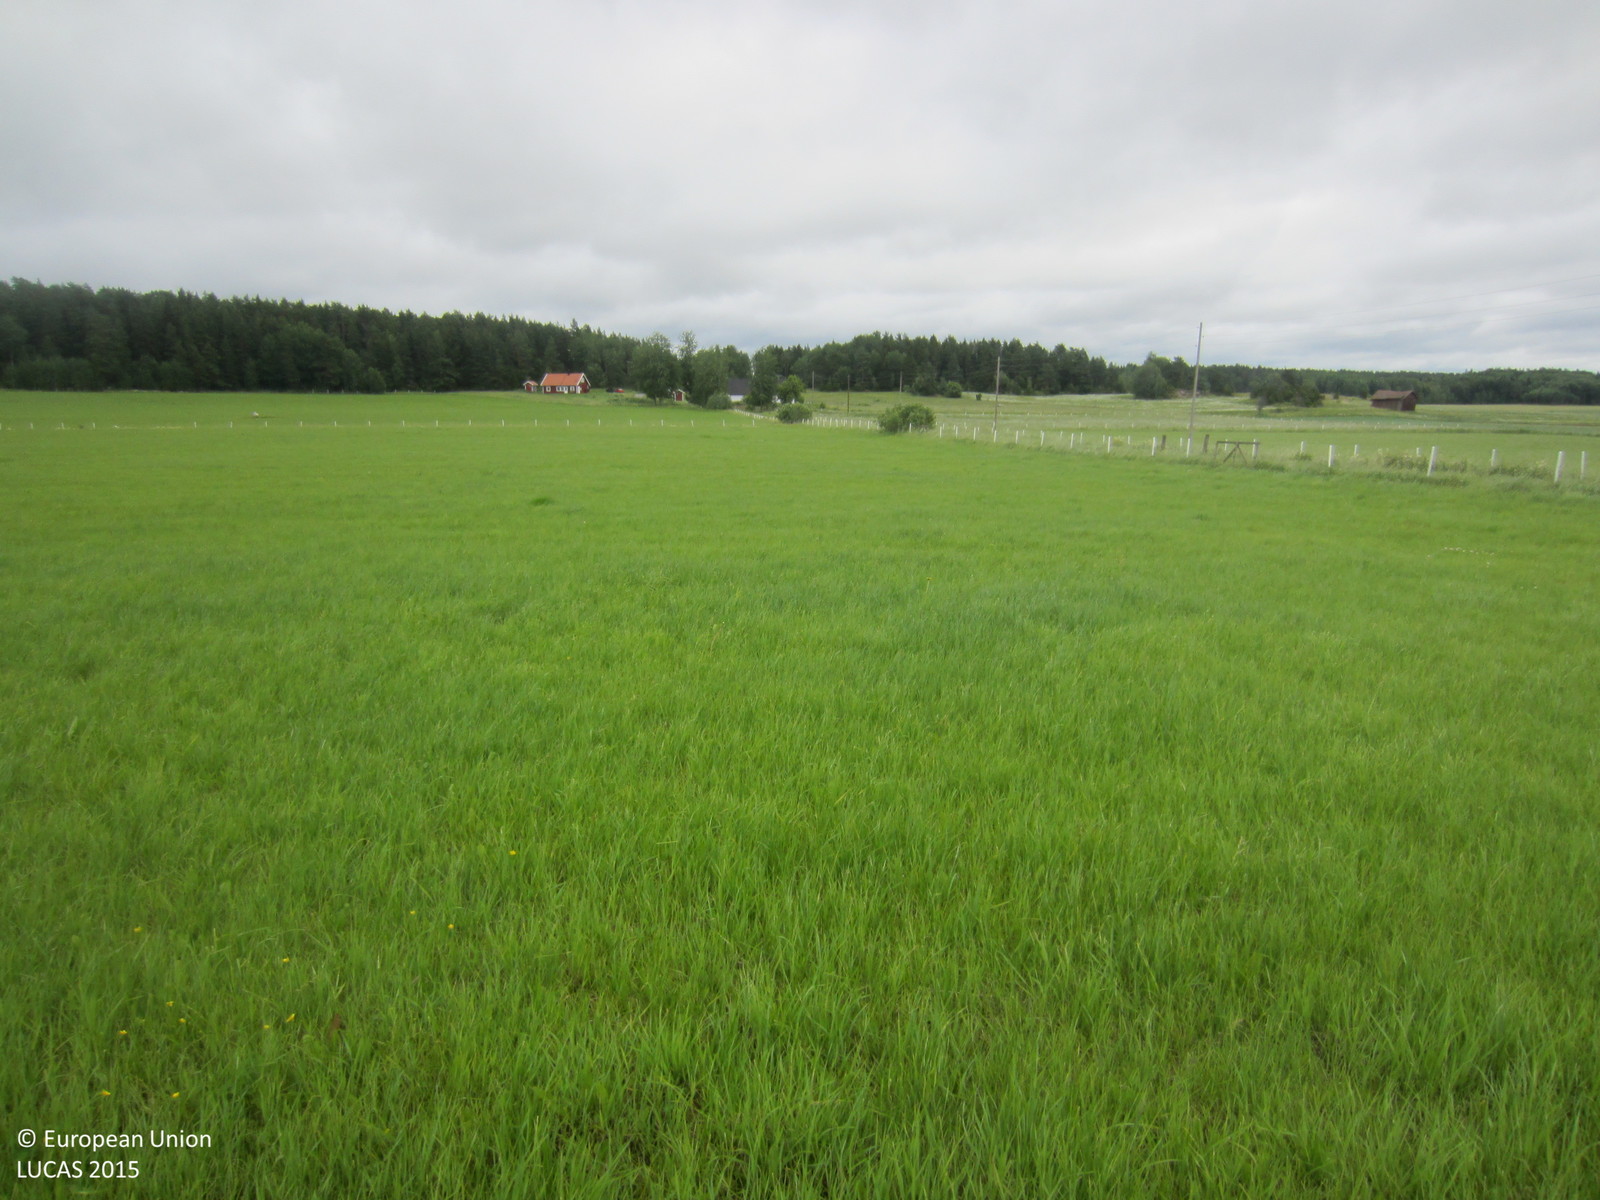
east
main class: Grassland
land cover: Grassland without tree/shrub cover
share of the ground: > 75 %
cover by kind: herbaceous plants 100 %
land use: Agriculture (excluding fallow land and kitchen gardens)
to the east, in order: Grassland without tree/shrub cover; Fences; Grass margins; Ditches and canals; Paved roads, cycling and walking lanes; Ditches and canals; Grass margins; Fences; Grassland without tree/shrub cover
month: July
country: SE
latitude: 59.8009
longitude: 17.1400
